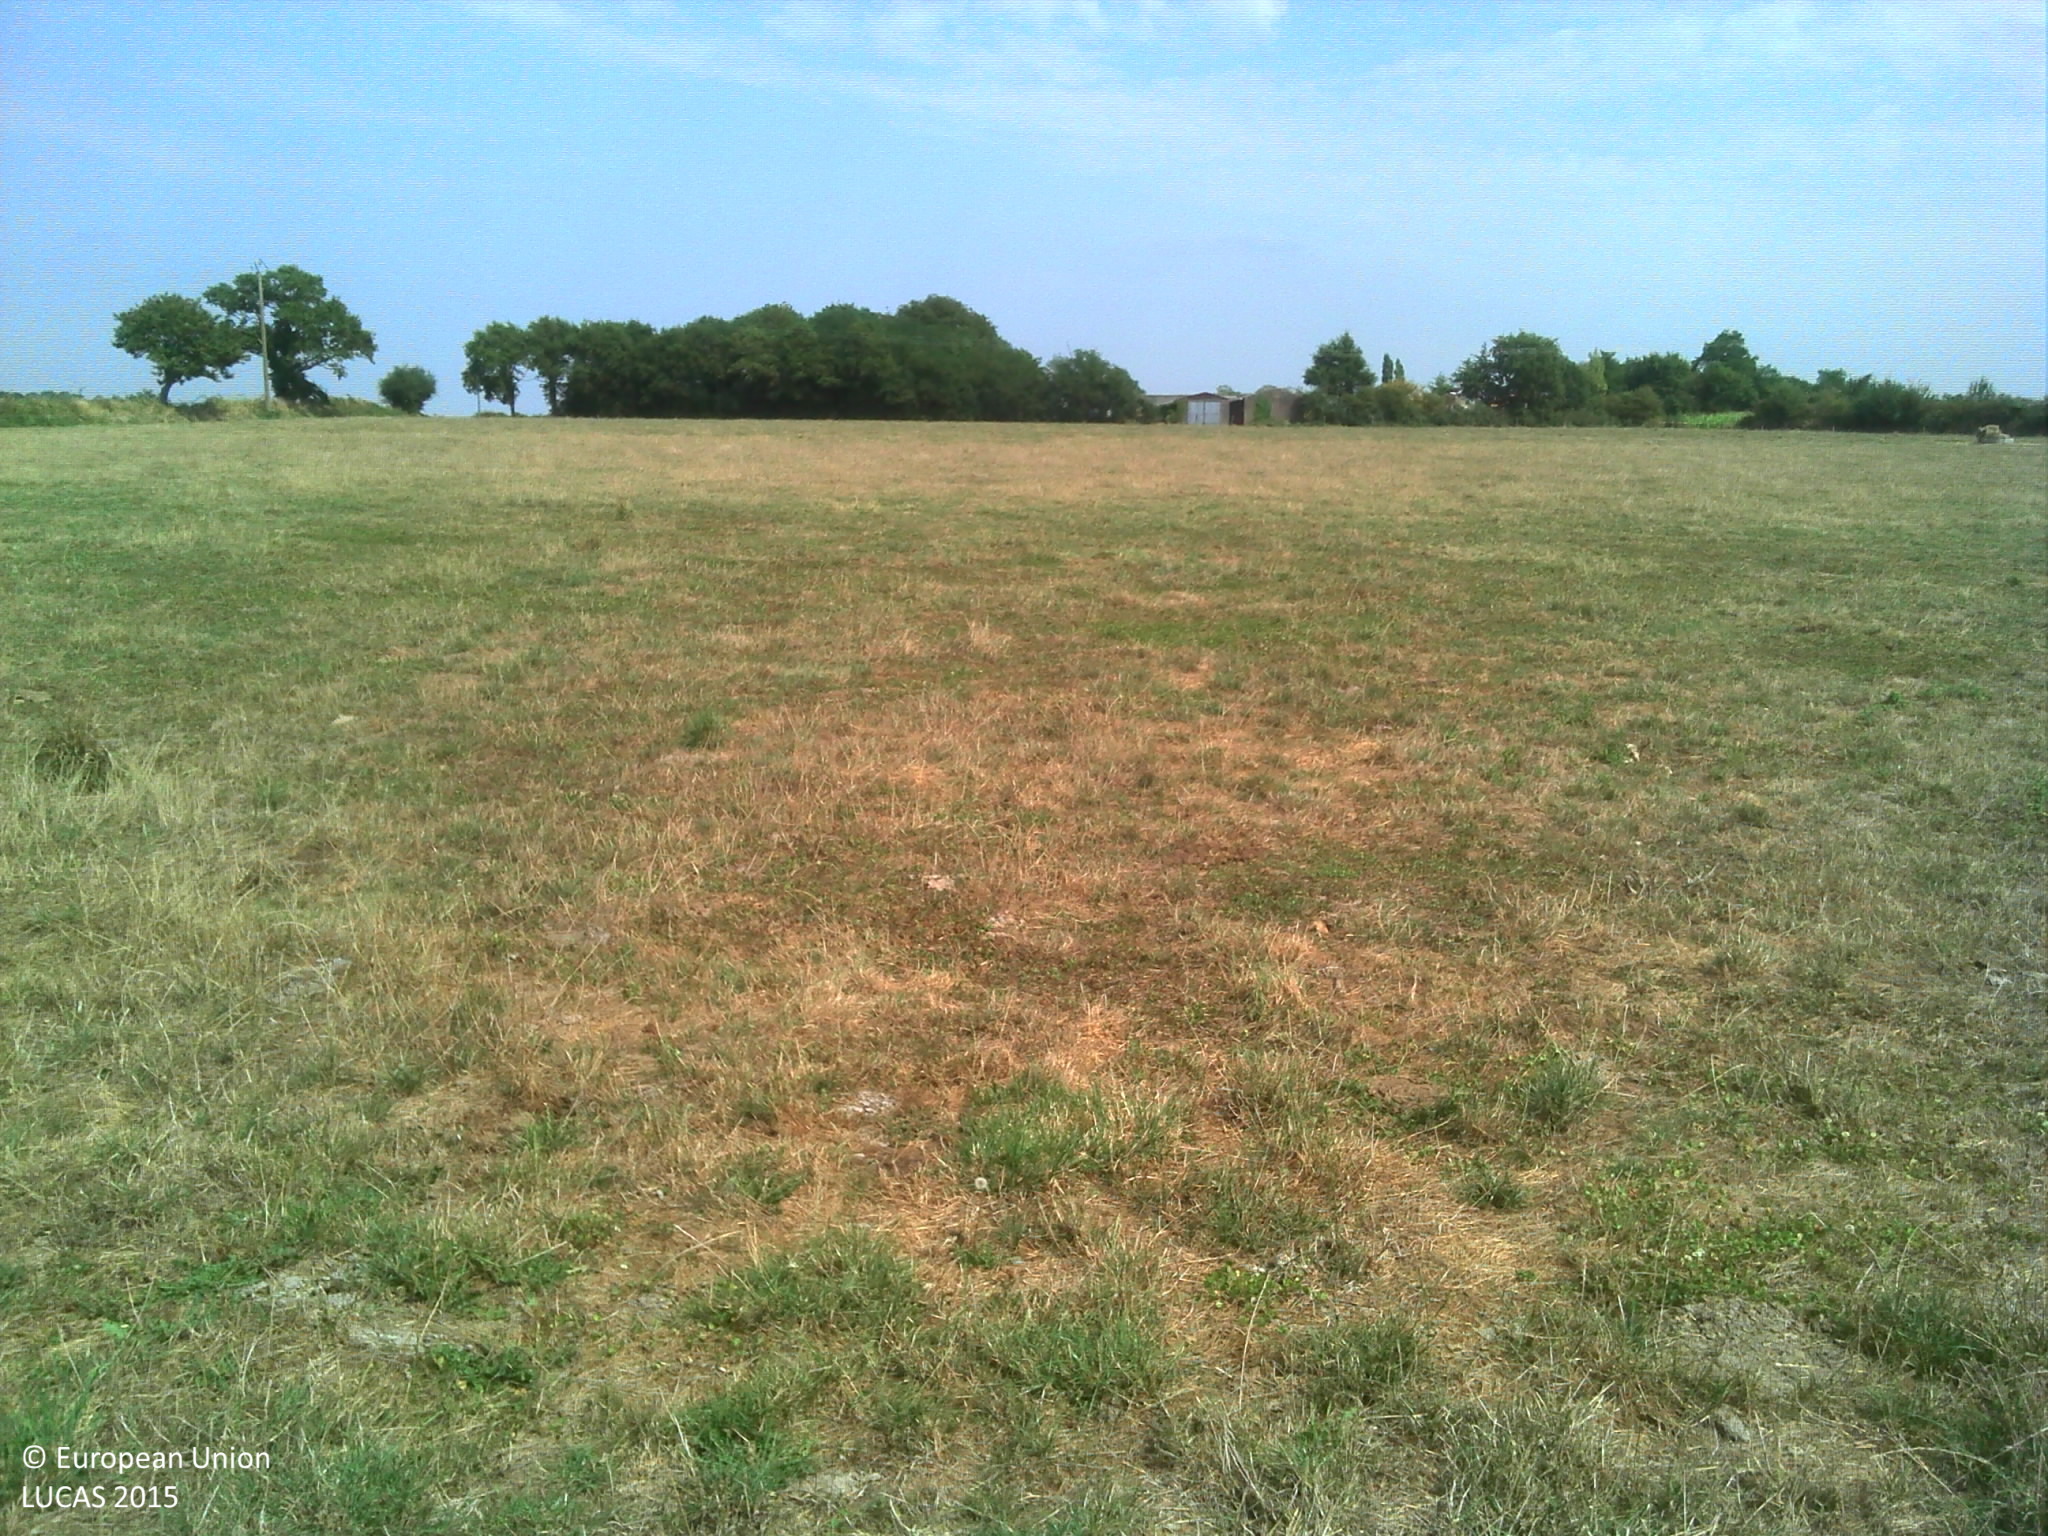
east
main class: Grassland
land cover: Grassland without tree/shrub cover
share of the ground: > 75 %
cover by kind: herbaceous plants 100 %
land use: Agriculture (excluding fallow land and kitchen gardens)
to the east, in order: Grassland without tree/shrub cover; Electric lines; Grassland without tree/shrub cover; Fences; Broadleaved woodland; Artificial constructions in urban areas
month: August
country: FR
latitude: 46.6785
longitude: -1.7952
